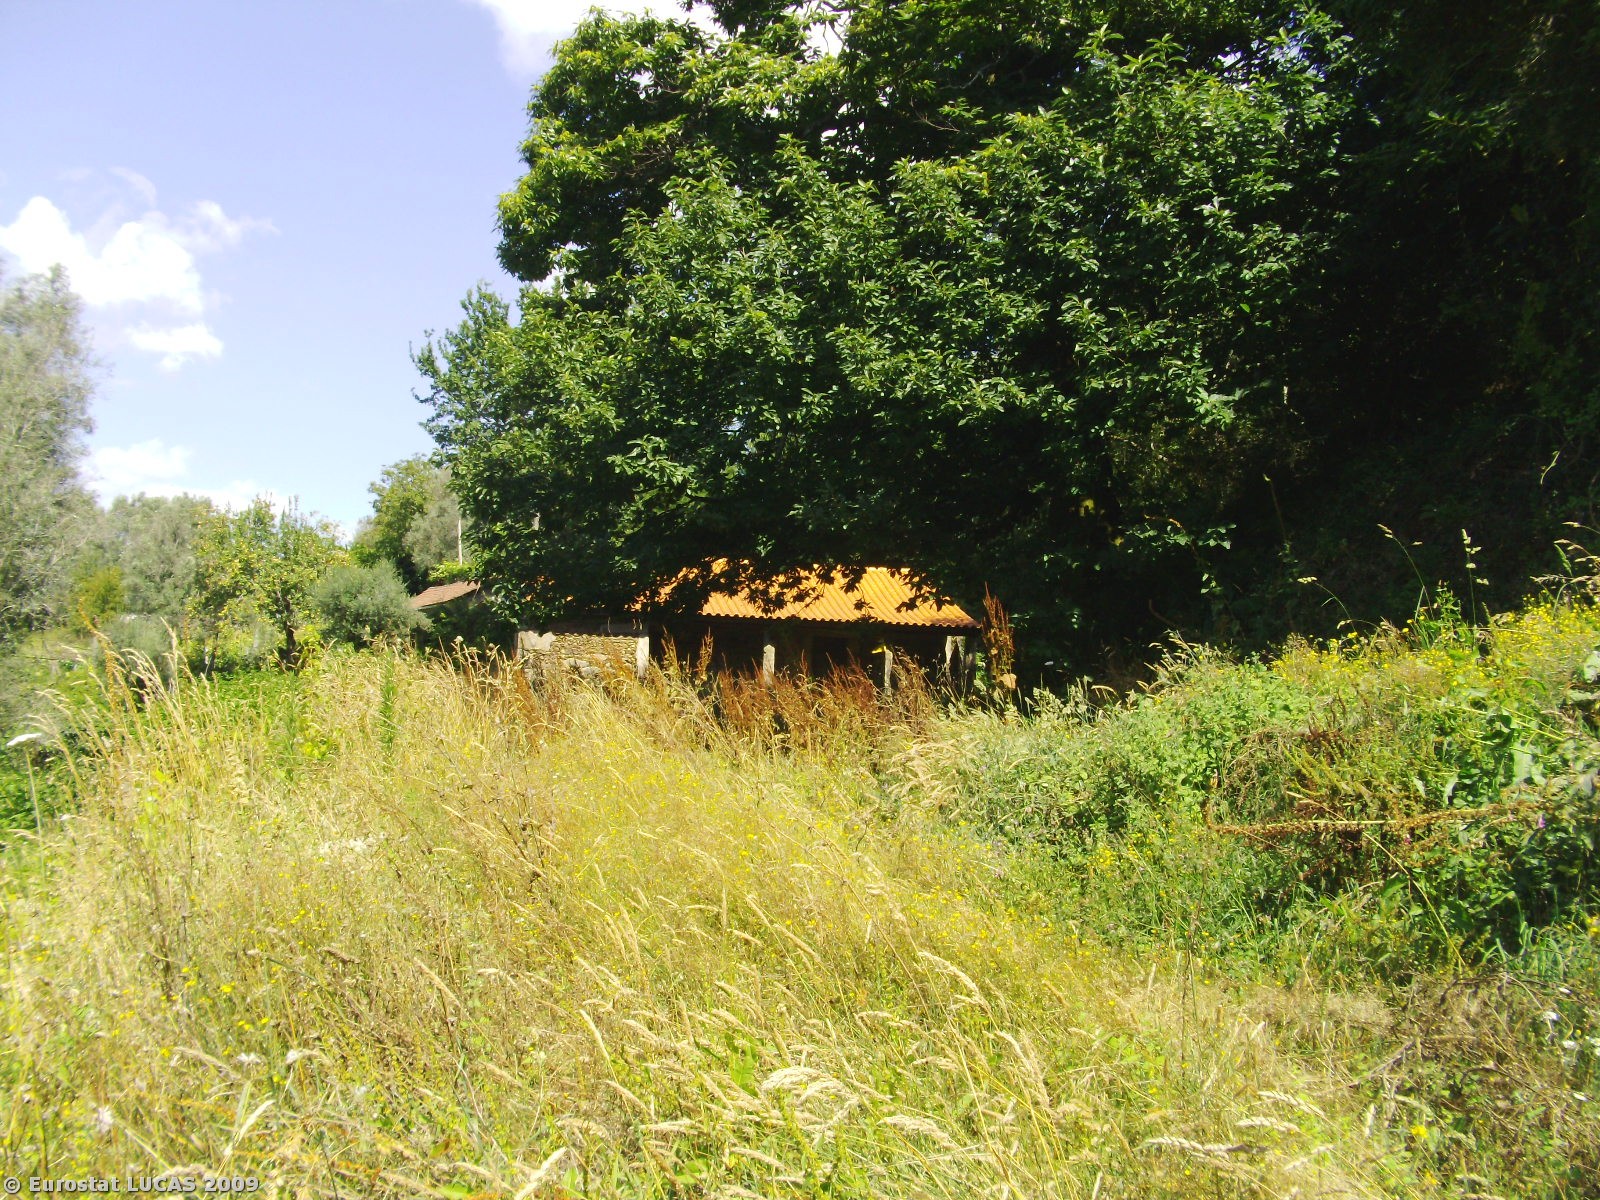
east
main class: Grassland
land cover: Spontaneously vegetated surfaces
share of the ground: > 75 %
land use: Fallow land
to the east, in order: Spontaneously vegetated surfaces; Abandoned hedges; Spontaneously vegetated surfaces; Artificial constructions in urban areas; Arable land (only in case pi); Tracks; Vineyards; Arable land (only in case pi); Vineyards; Artificial constructions in urban areas; Vineyards; Electric lines; Dry stone walls; Tracks; Vineyards; Abandoned hedges; Spontaneously vegetated surfaces; Other fresh vegetables; Maize; Spontaneously vegetated surfaces
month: July
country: PT
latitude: 41.7151
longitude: -8.5622
